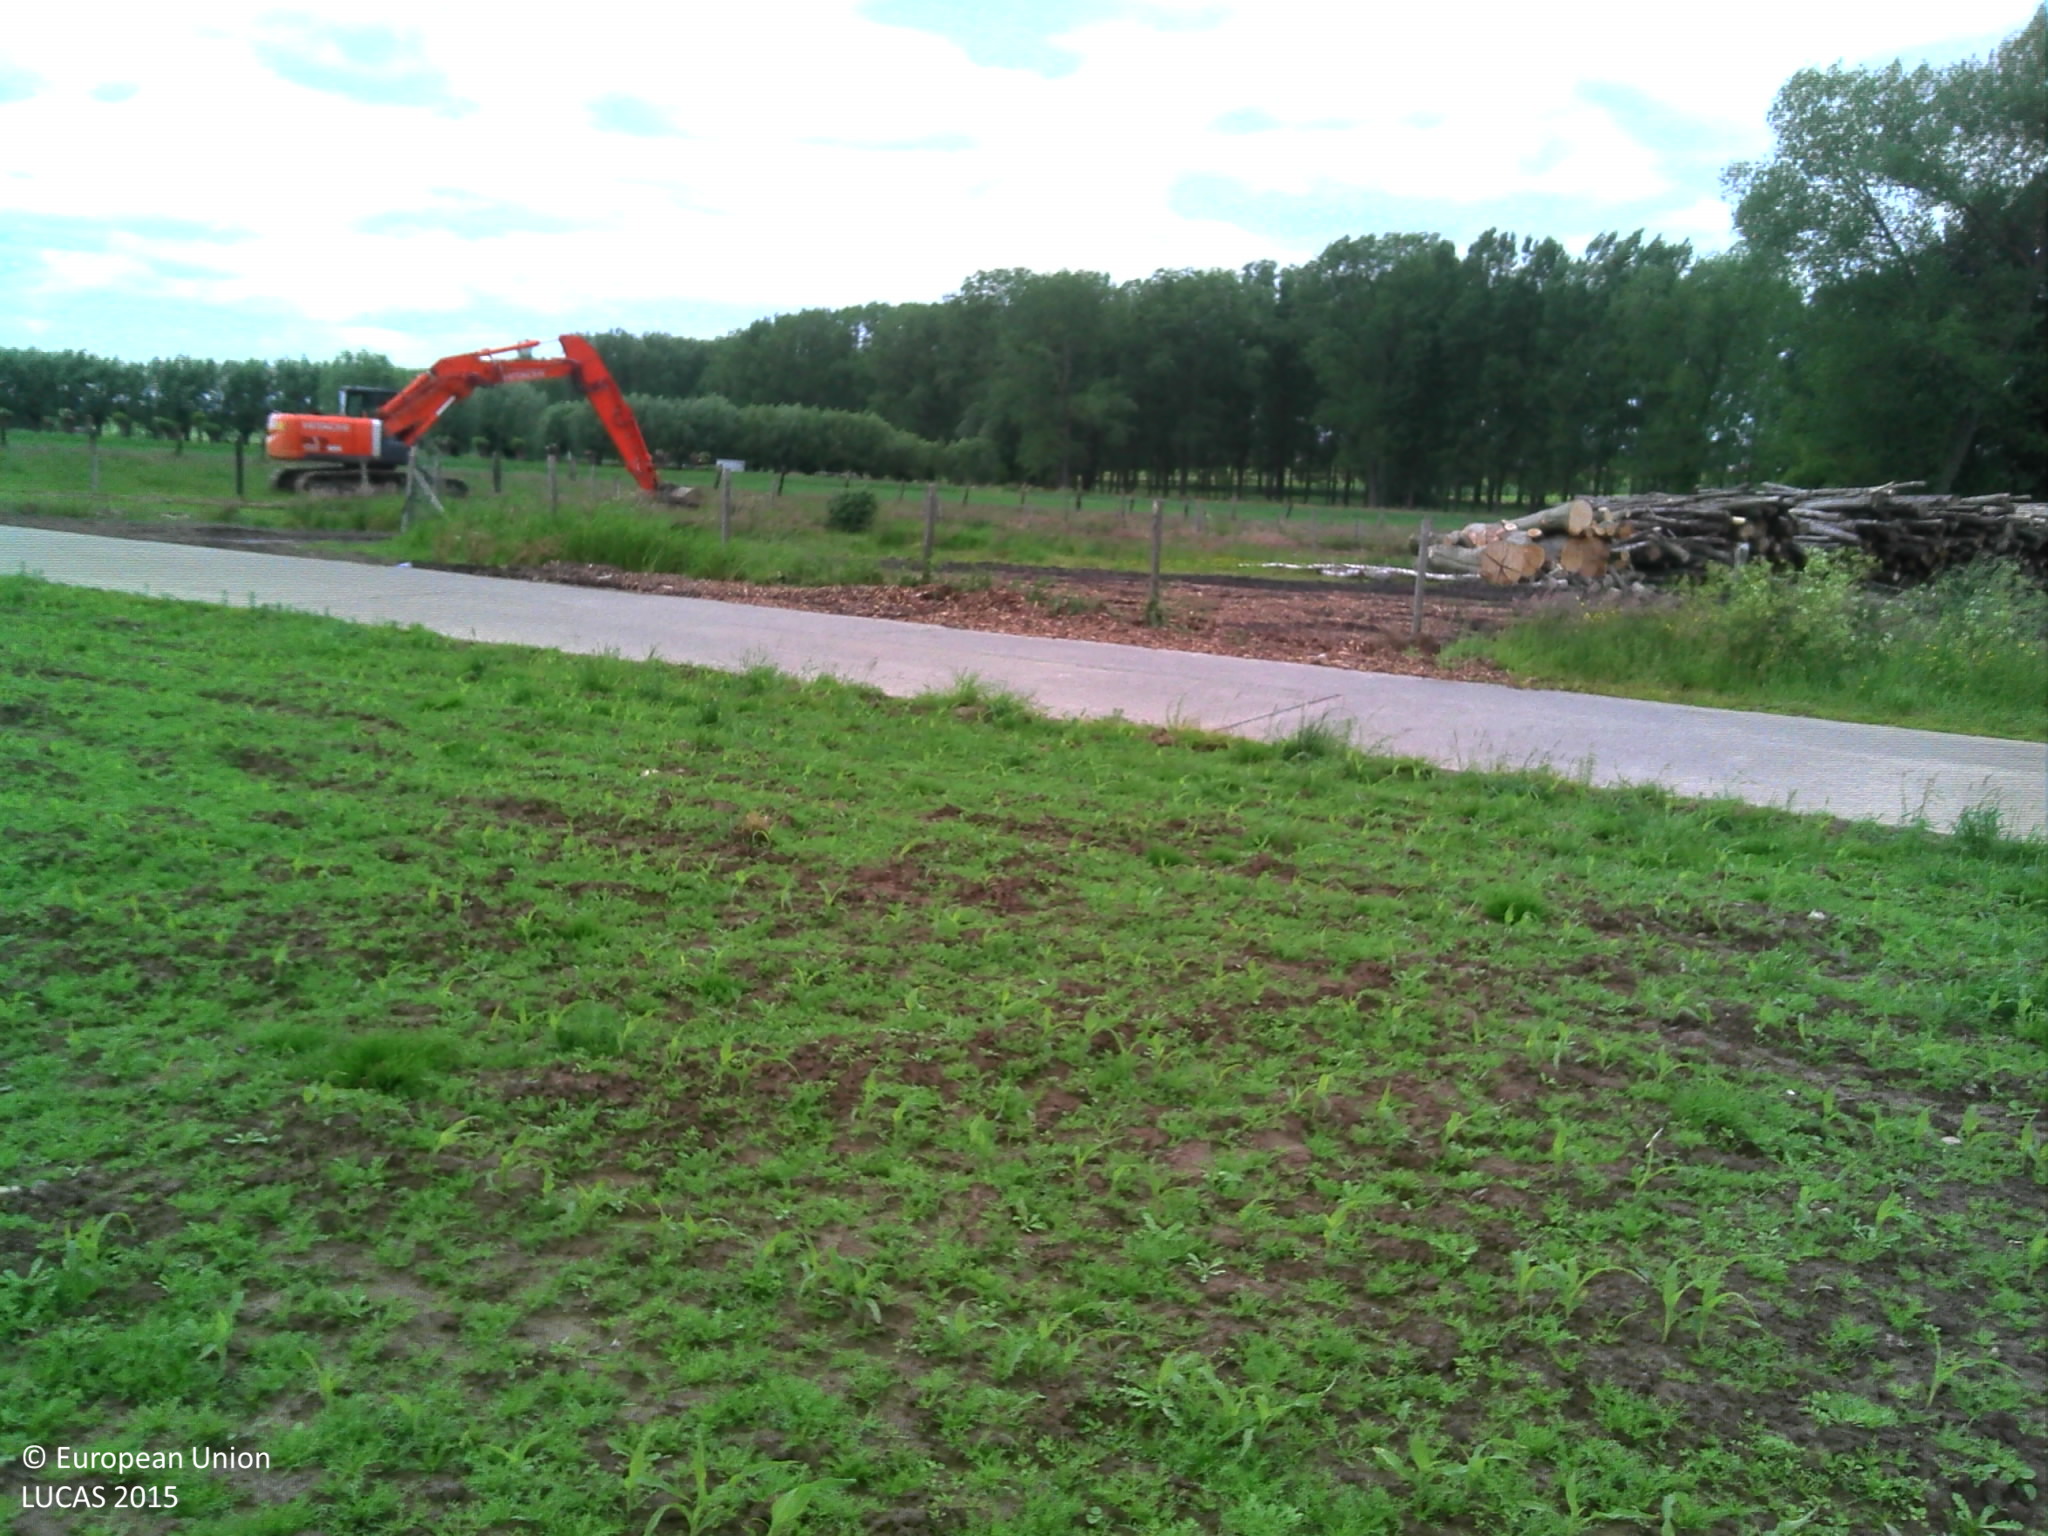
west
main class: Cropland
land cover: Maize
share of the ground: 10 - 25 %
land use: Agriculture (excluding fallow land and kitchen gardens)
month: June
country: BE
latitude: 50.8131
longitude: 3.8767
